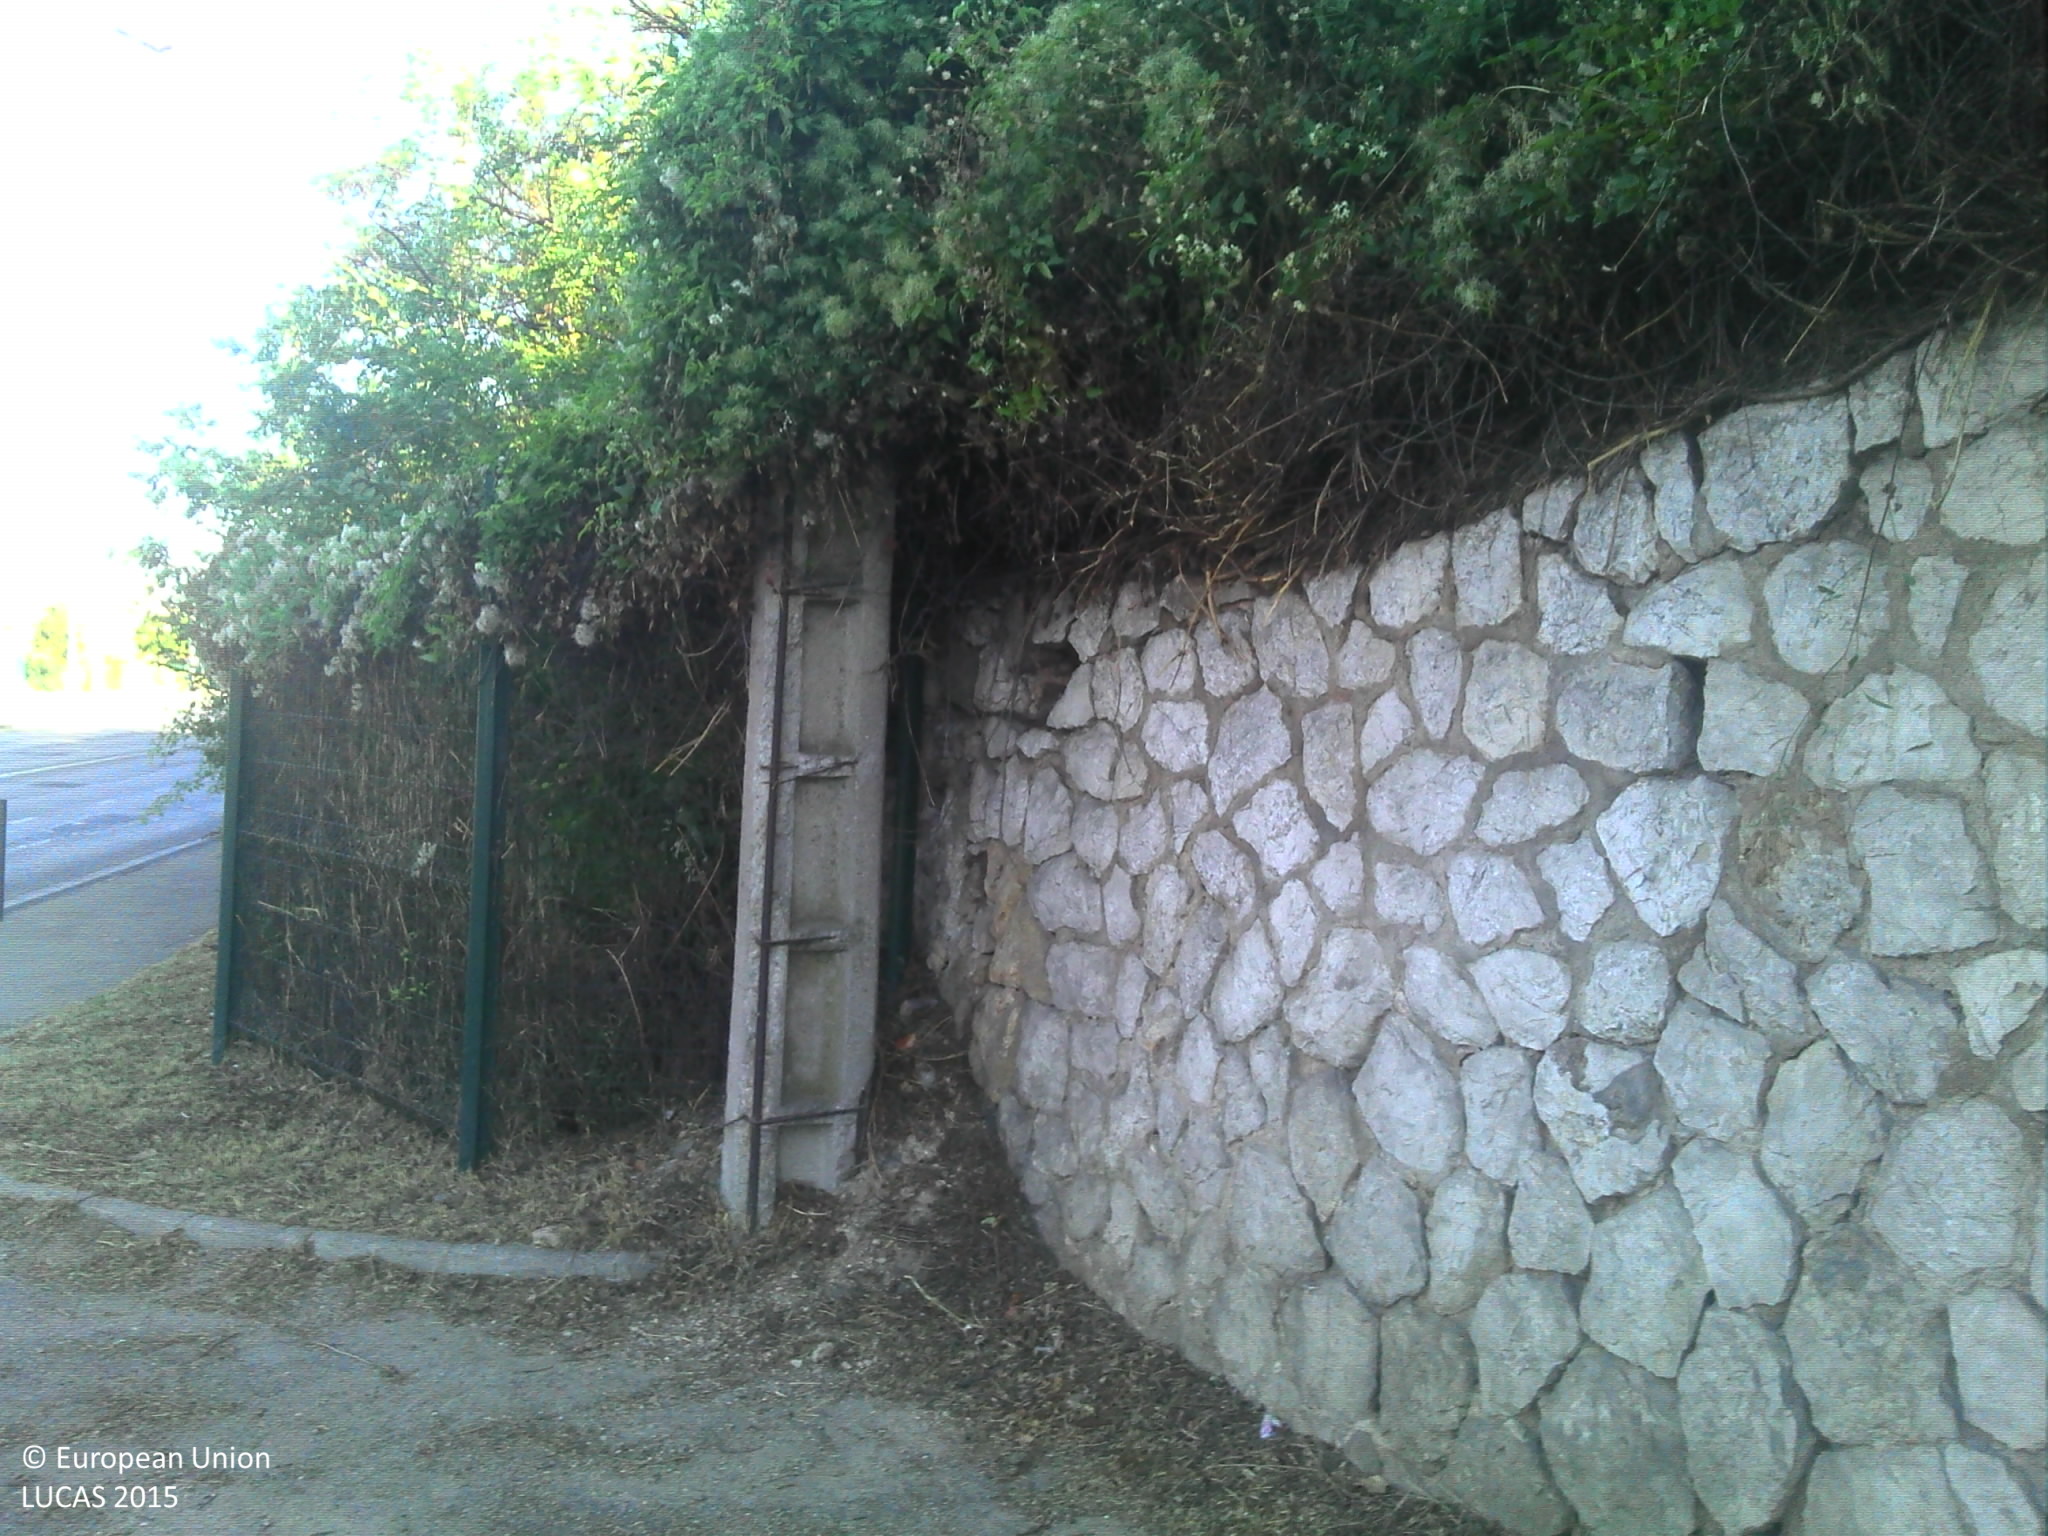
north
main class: Grassland
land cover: Spontaneously vegetated surfaces
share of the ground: > 75 %
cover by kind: consolidated bare surface 70 %, herbaceous plants 30 %
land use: Railway transport
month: August
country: FR
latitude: 43.3444
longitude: 5.3843
